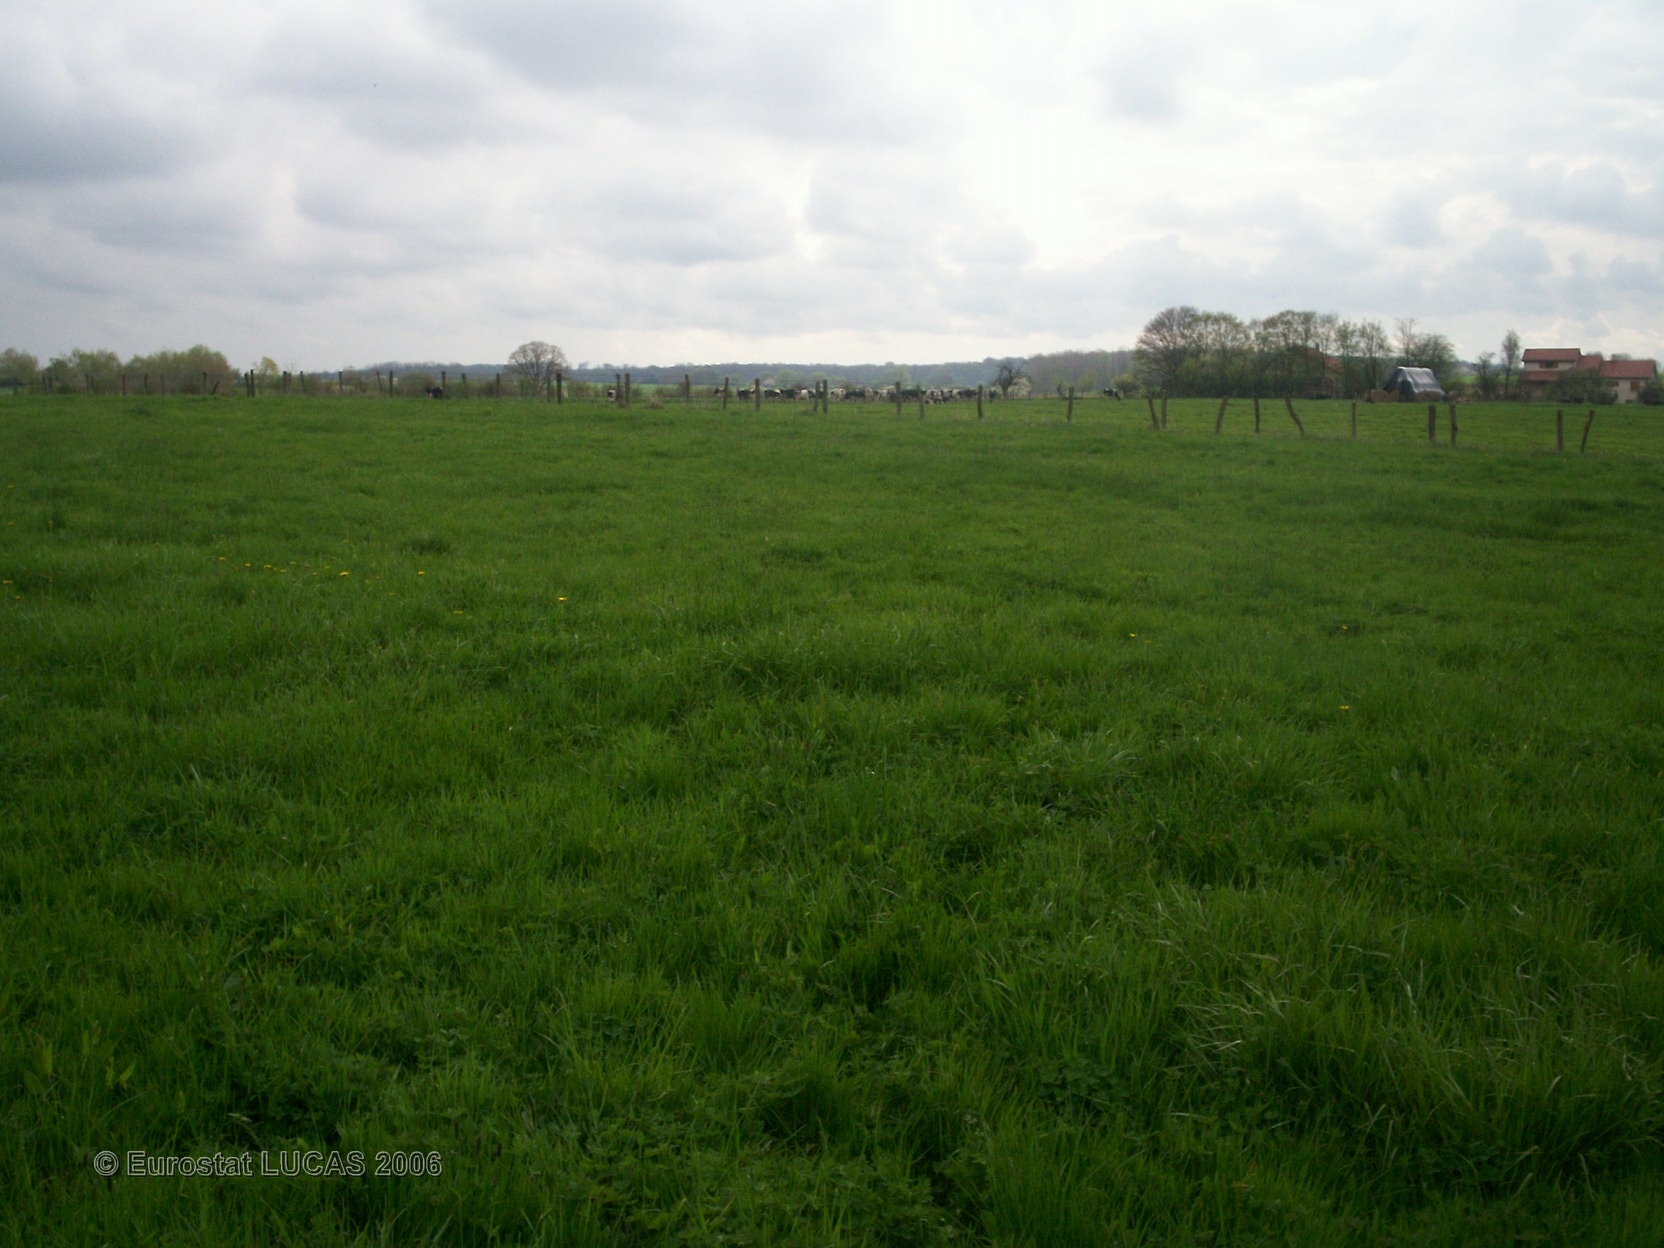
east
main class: Grassland
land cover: Grassland without tree/shrub cover
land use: Agriculture (excluding fallow land and kitchen gardens)
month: April
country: FR
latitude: 48.8058
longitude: 6.7462
